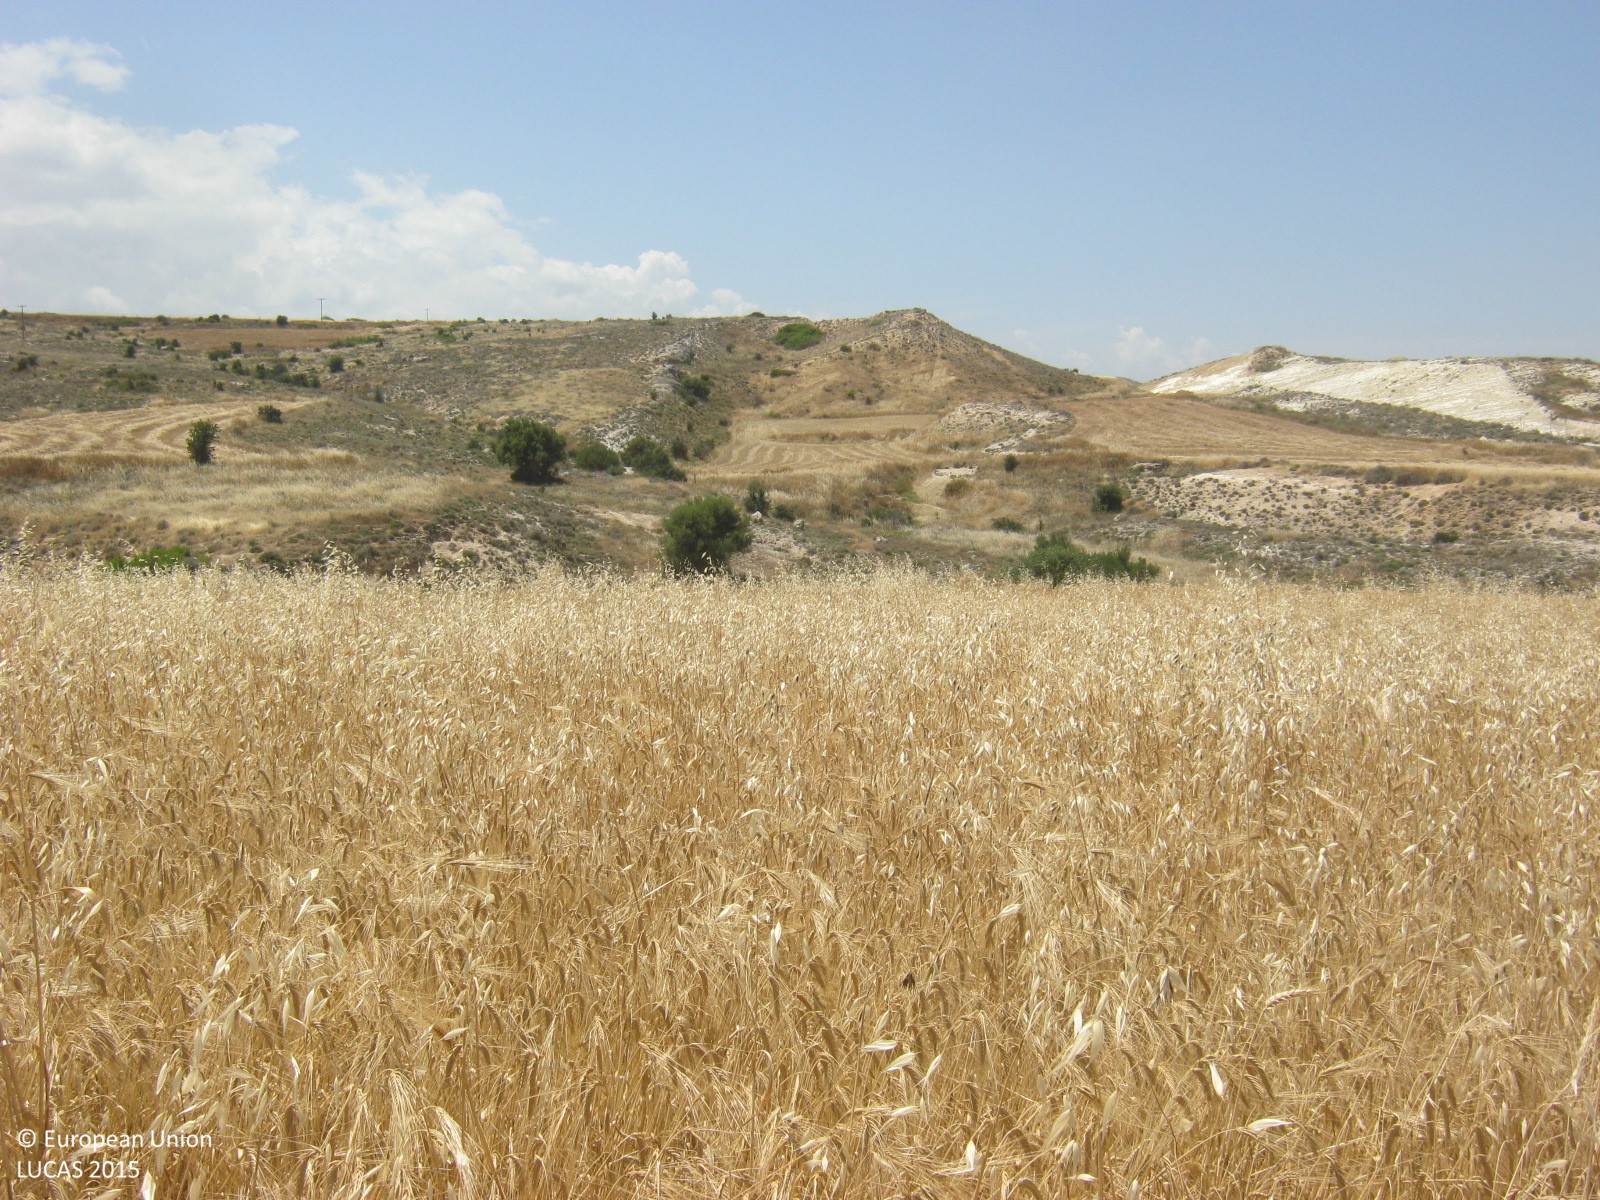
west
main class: Cropland
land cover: Mixed cereals for fodder
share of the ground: > 75 %
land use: Agriculture (excluding fallow land and kitchen gardens)
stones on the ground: < 10 %
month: May
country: CY
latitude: 35.0660
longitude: 33.1094
